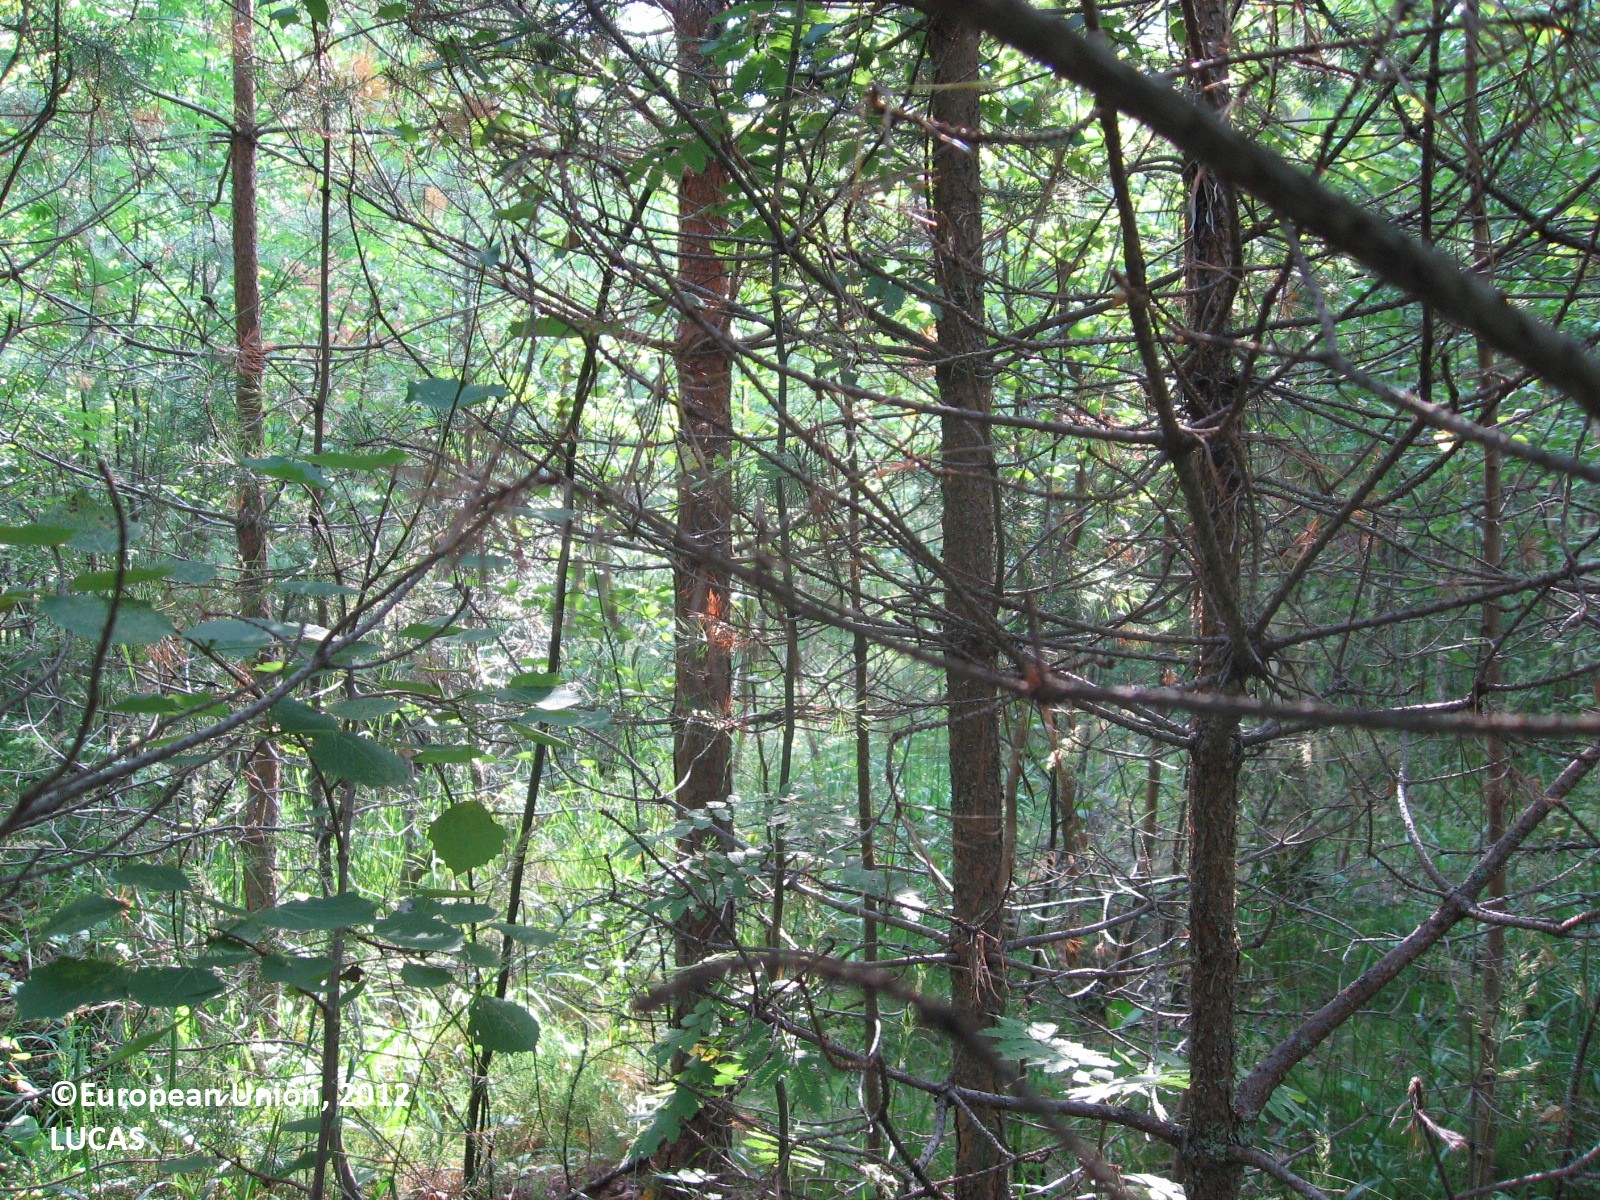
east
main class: Woodland
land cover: Pine dominated mixed woodland
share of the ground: > 75 %
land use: Forestry
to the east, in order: Pine dominated mixed woodland; Pine dominated coniferous woodland; Paved roads, cycling and walking lanes; Pine dominated mixed woodland; Ditches and canals; Grass margins; Paved roads, cycling and walking lanes; Grass margins; Ditches and canals; Electric lines; Pine dominated coniferous woodland
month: August
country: FI
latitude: 61.4758
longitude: 25.9578
